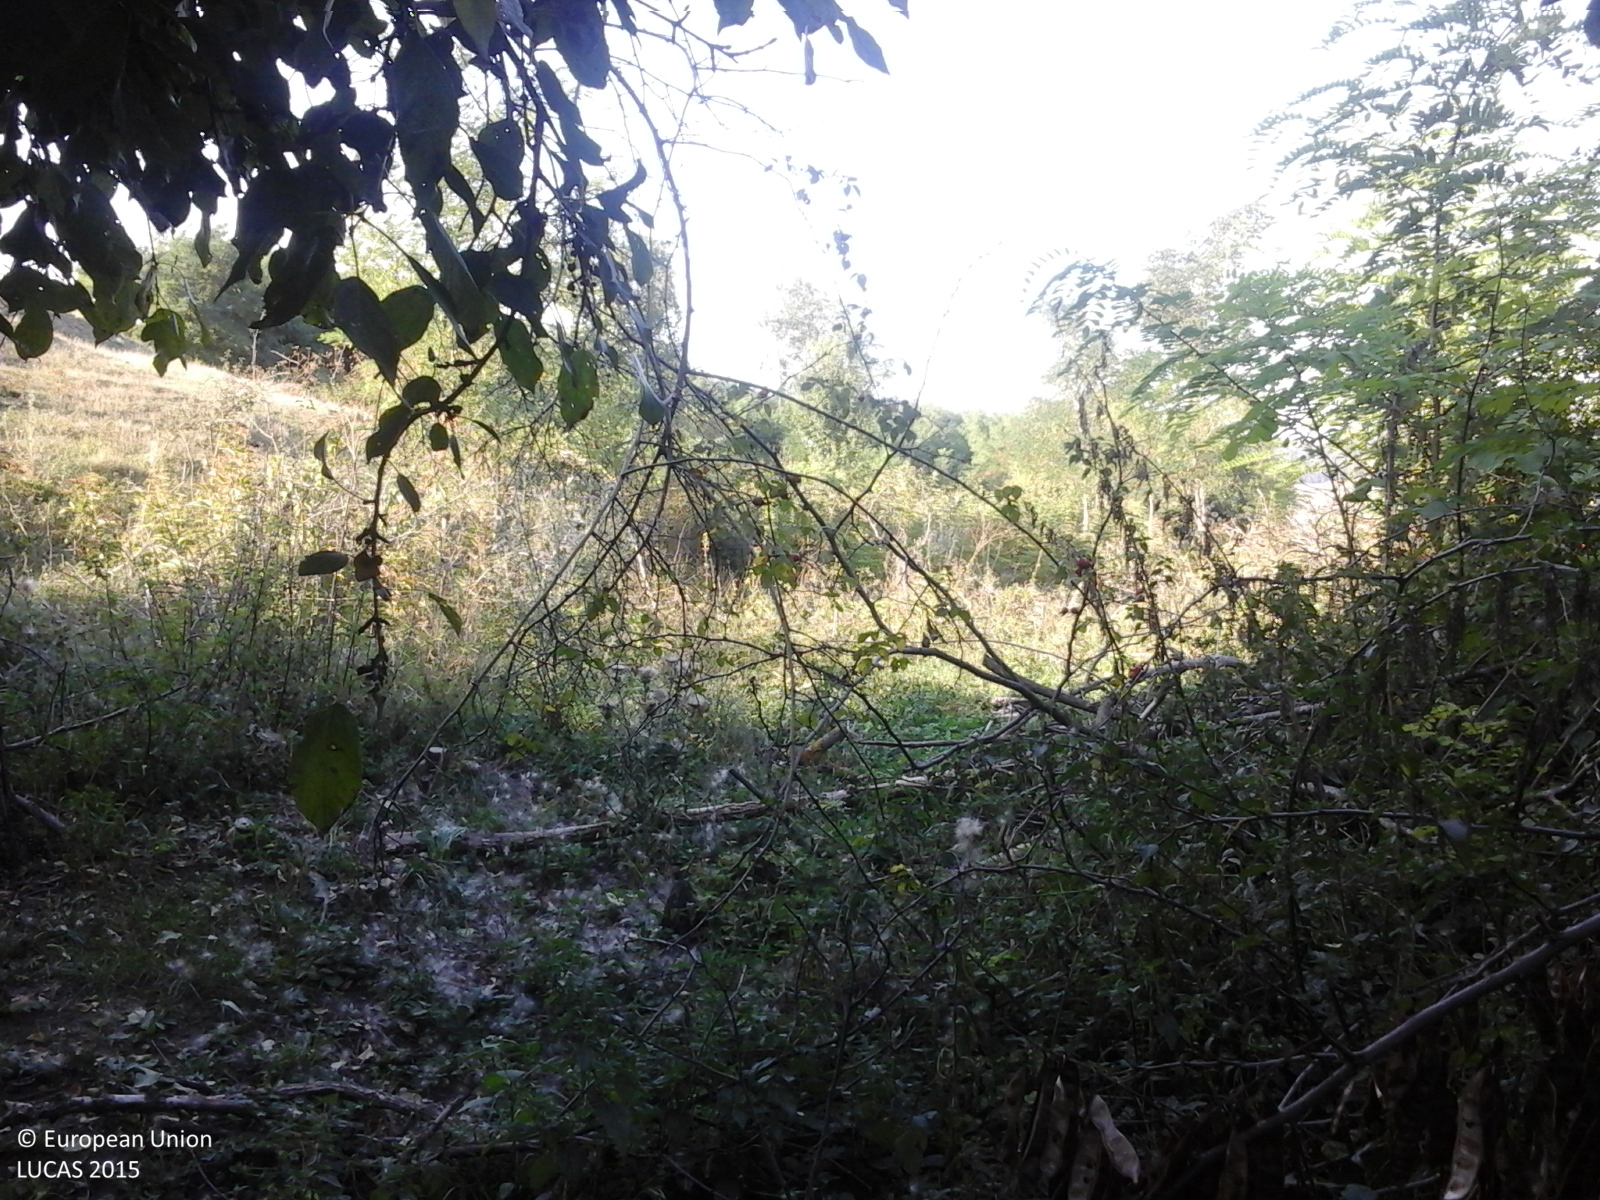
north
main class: Woodland
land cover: Broadleaved woodland
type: thermophilous deciduous forest
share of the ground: > 75 %
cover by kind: broadleaved forest trees 100 %
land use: Forestry
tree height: > 5 m
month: September
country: RO
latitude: 46.7359
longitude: 24.4435
